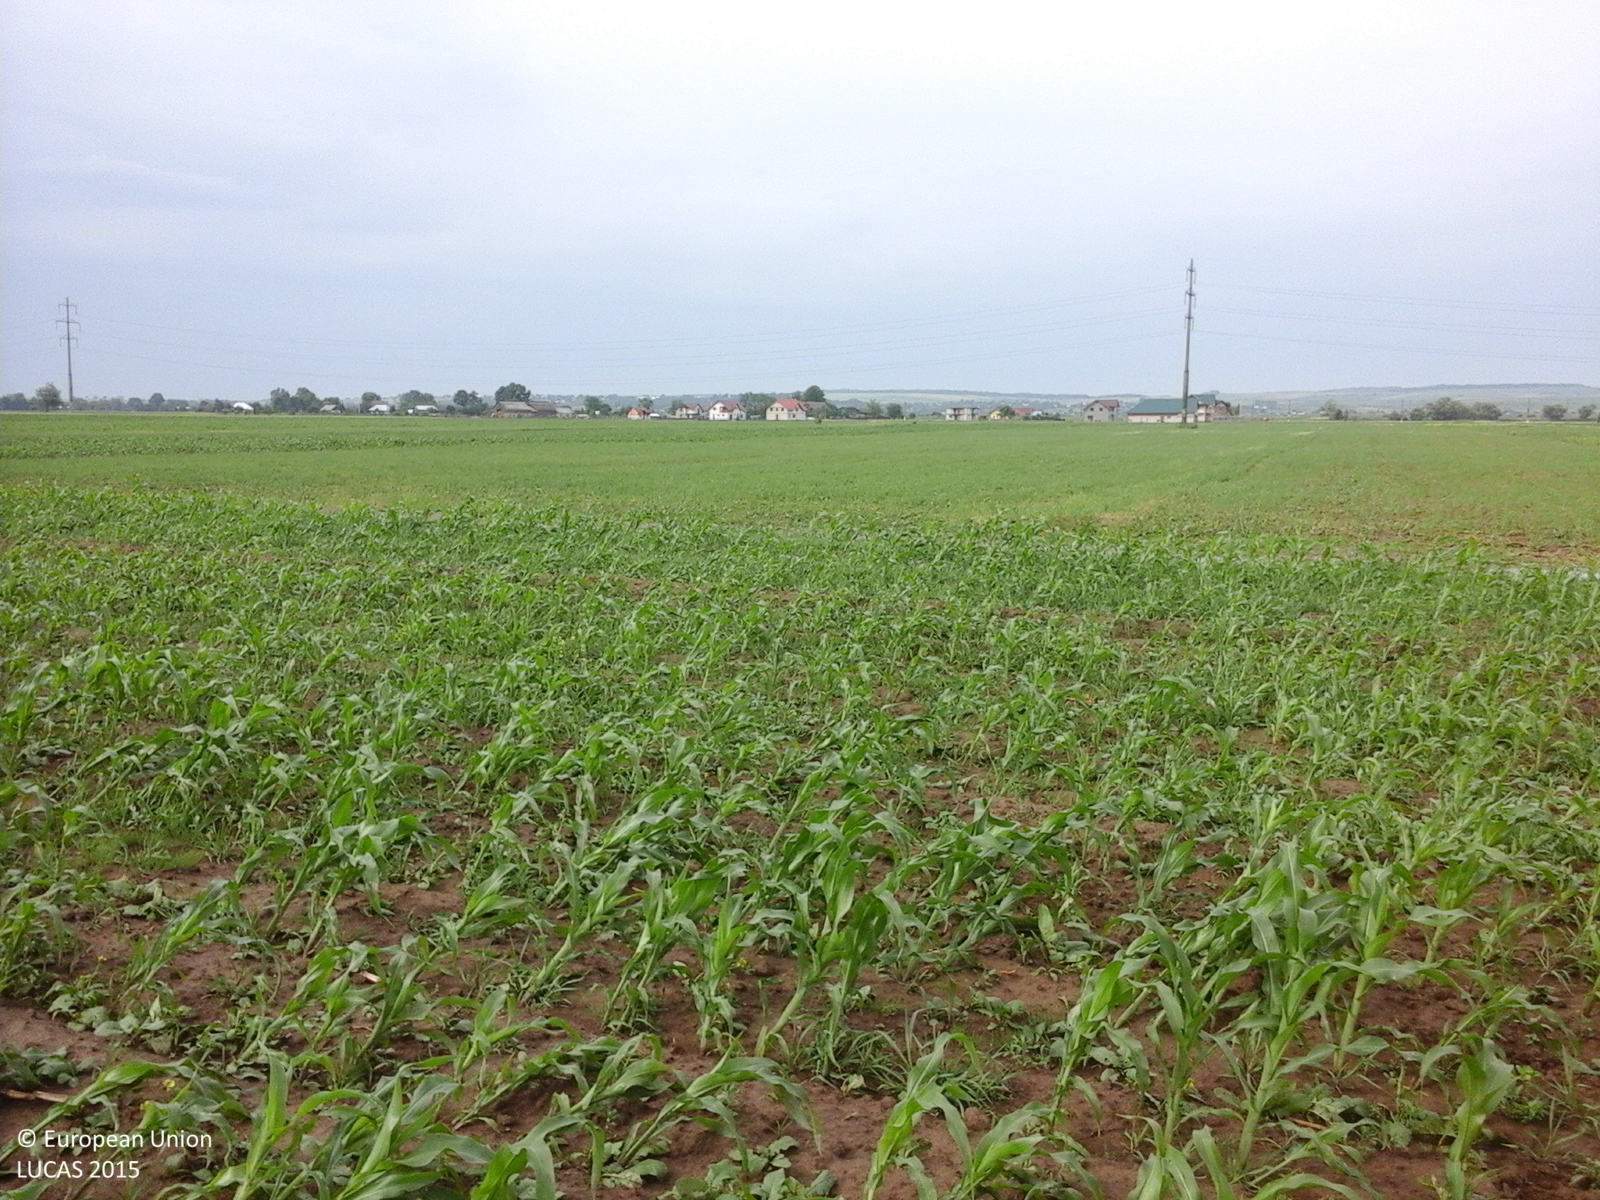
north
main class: Cropland
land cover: Maize
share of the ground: 50 - 75 %
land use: Agriculture (excluding fallow land and kitchen gardens)
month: June
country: RO
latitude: 47.3621
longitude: 26.3297
